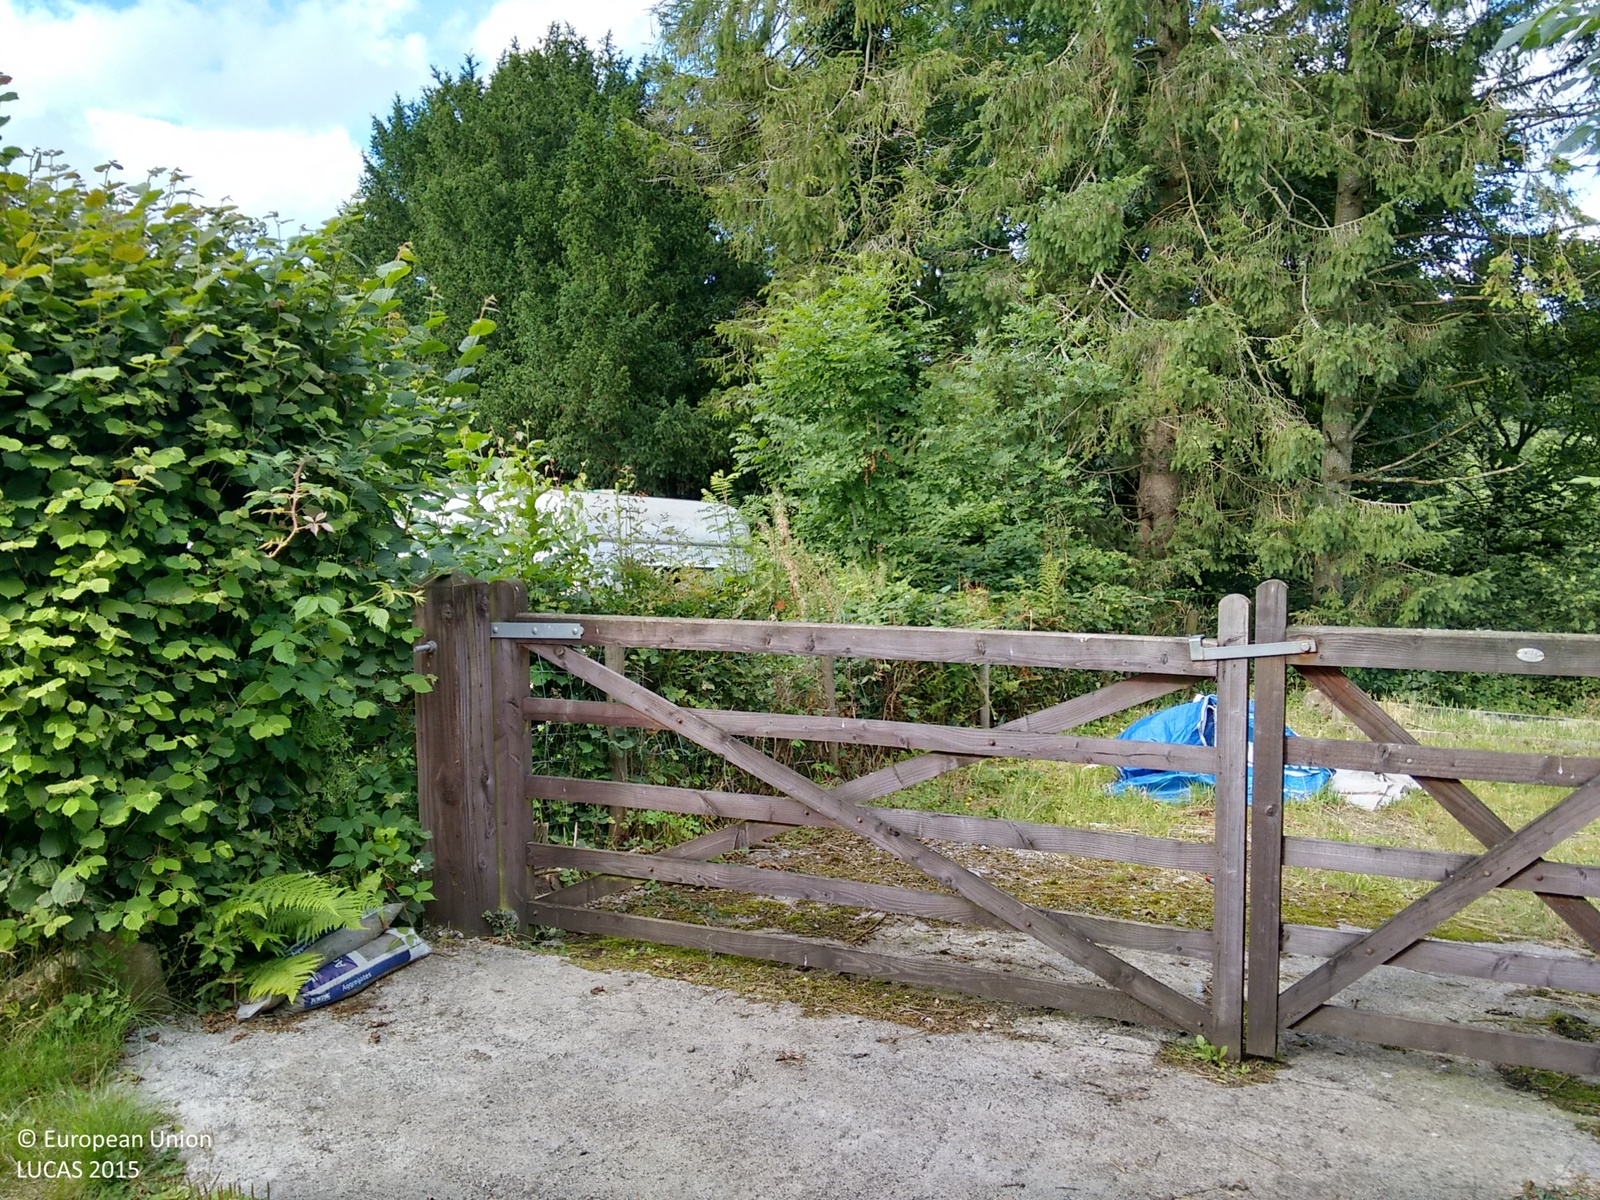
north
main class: Grassland
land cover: Grassland with sparse tree/shrub cover
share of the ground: > 75 %
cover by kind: herbaceous plants 95 %, broadleaved forest trees 5 %
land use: Residential
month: August
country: GB
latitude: 52.0584
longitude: -4.2621
